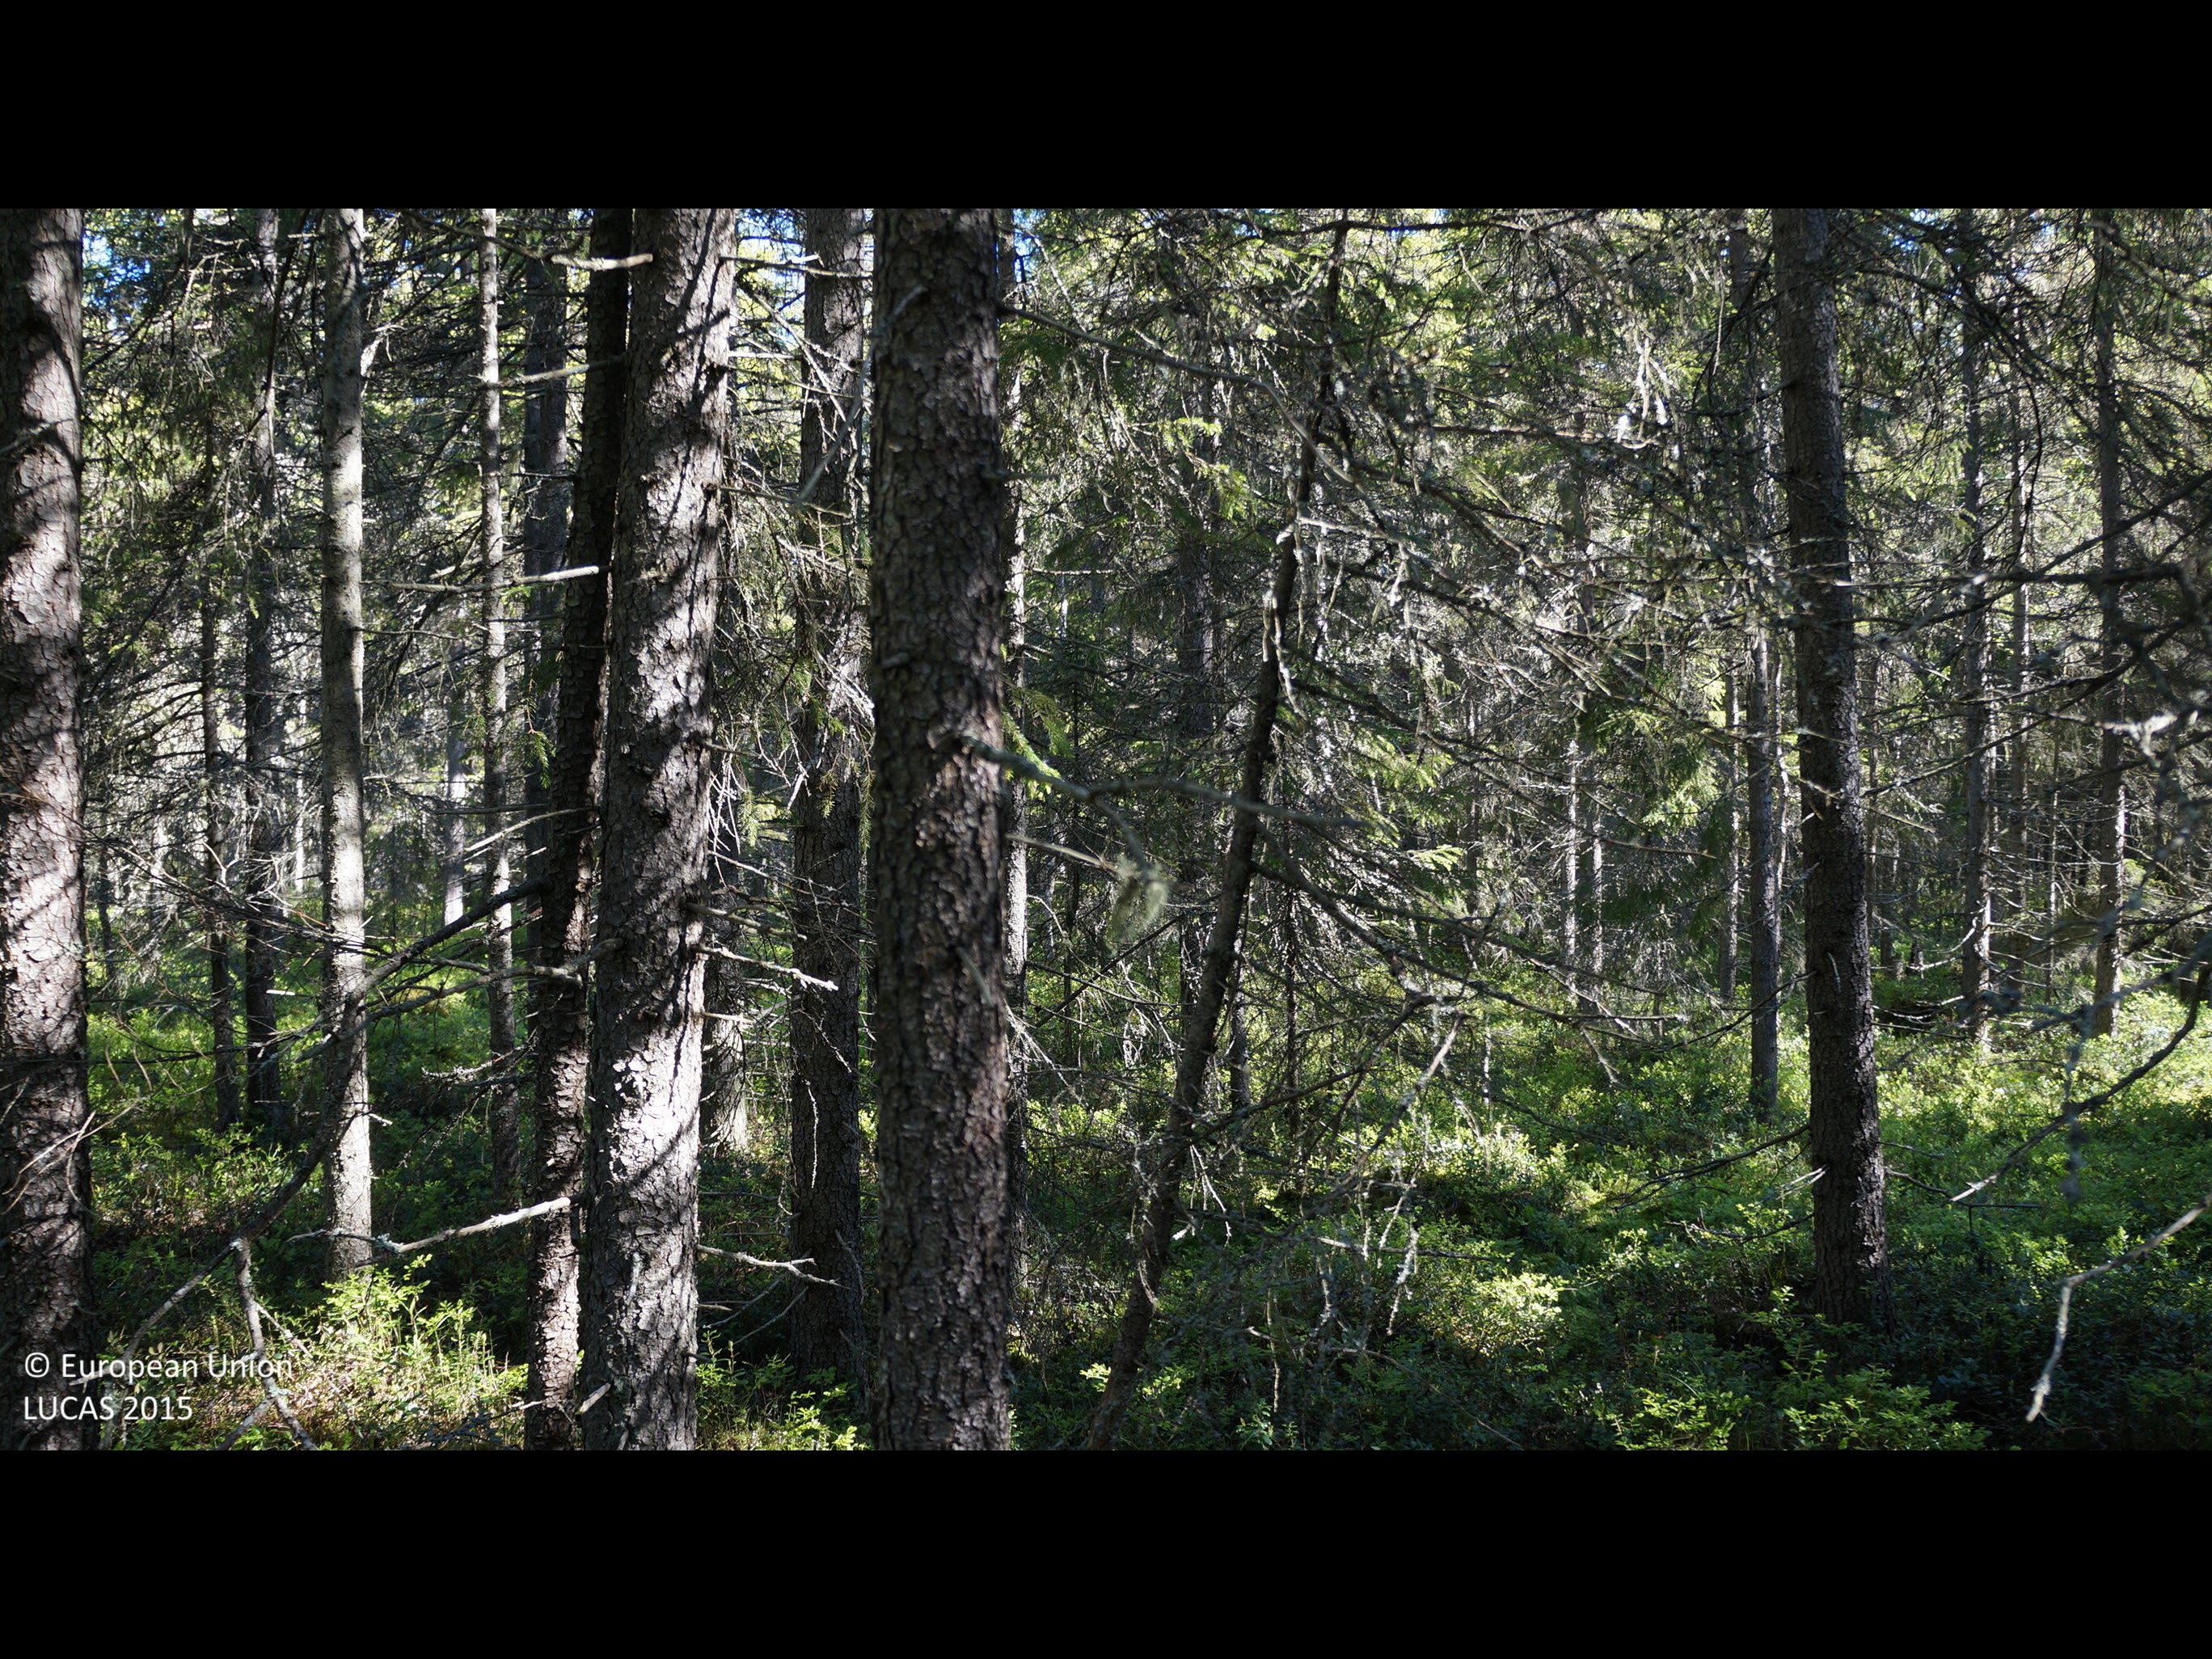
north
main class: Woodland
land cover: Spruce dominated coniferous woodland
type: boreal forest
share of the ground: > 75 %
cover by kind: coniferous forest trees 90 %, shrubs 5 %, herbaceous plants 5 %
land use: Forestry
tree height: > 5 m
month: June
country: FI
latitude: 64.3447
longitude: 23.9935
